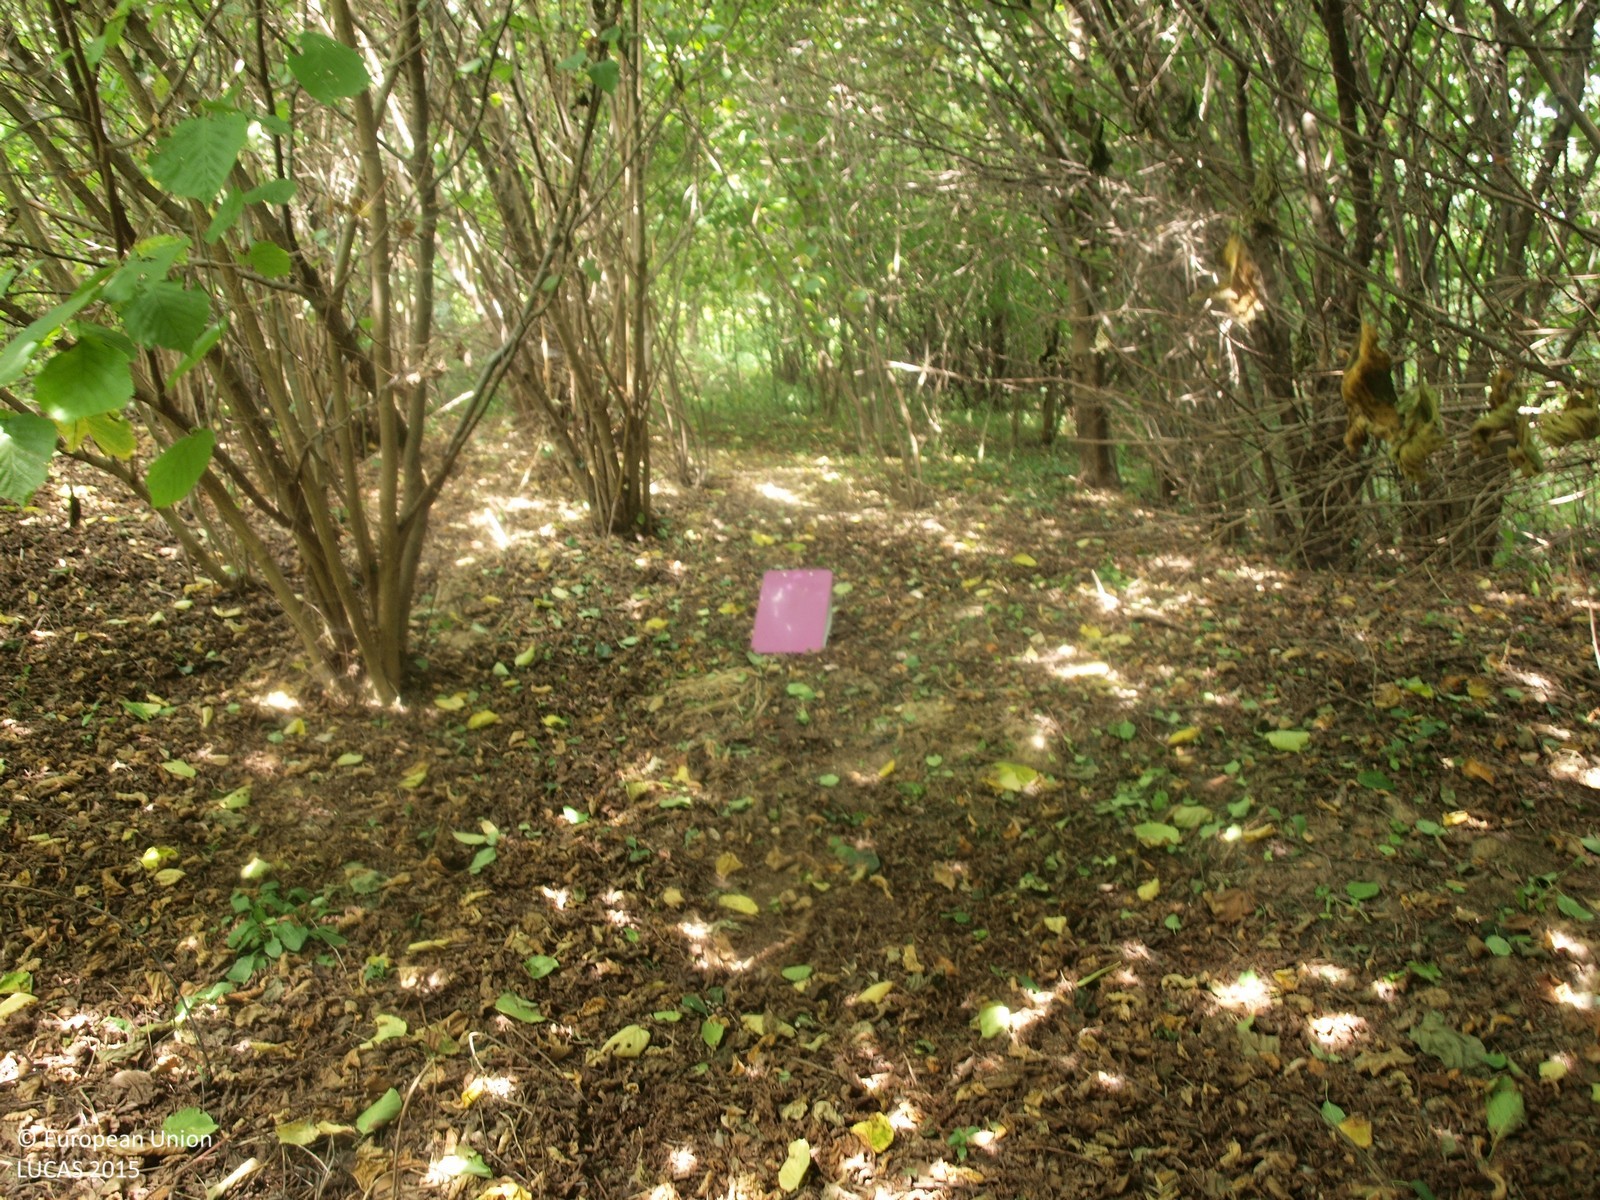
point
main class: Shrubland
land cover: Shrubland with sparse tree cover
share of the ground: > 75 %
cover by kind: shrubs 95 %, broadleaved forest trees 5 %
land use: Forestry
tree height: < 5 m
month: August
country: HR
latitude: 46.0887
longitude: 16.3757
